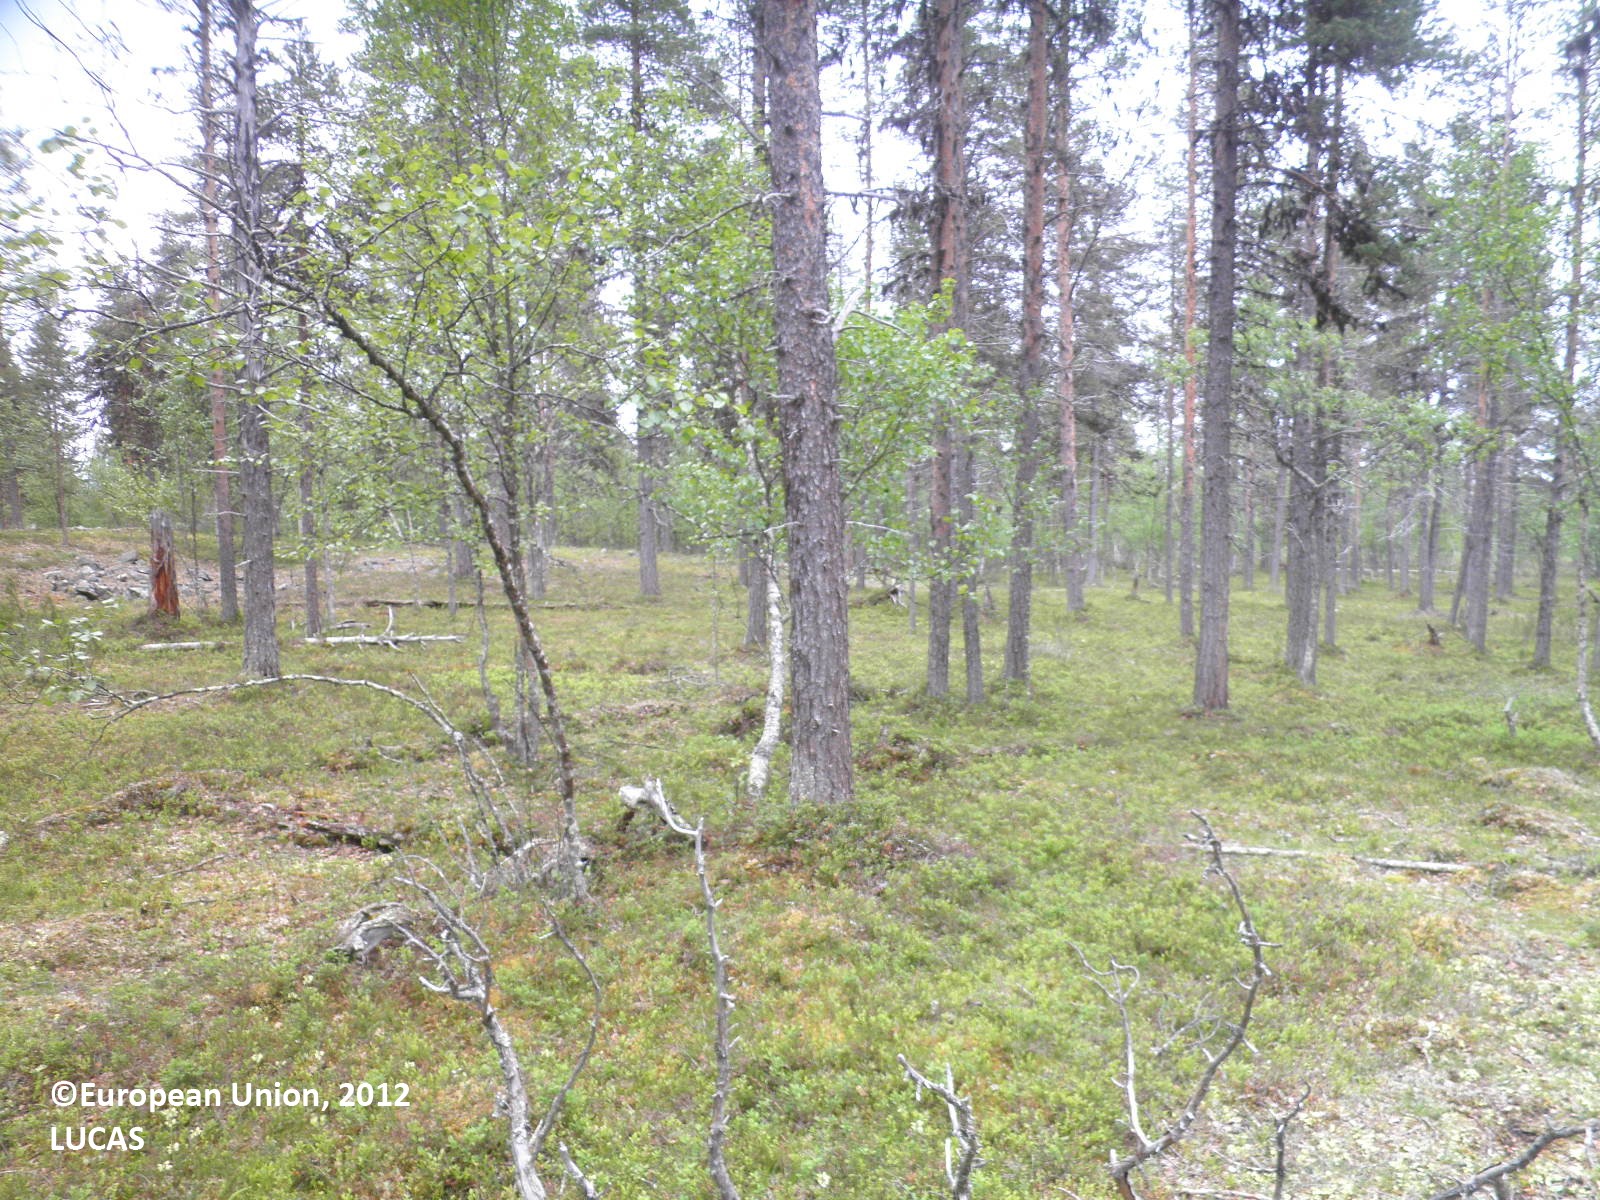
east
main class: Woodland
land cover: Pine dominated coniferous woodland
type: boreal forest
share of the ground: 25 - 50 %
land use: Forestry
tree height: > 5 m
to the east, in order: Pine dominated coniferous woodland; Pine dominated mixed woodland; Ditches and canals; Grass margins; Paved roads, cycling and walking lanes
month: July
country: FI
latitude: 68.4322
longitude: 25.9115
